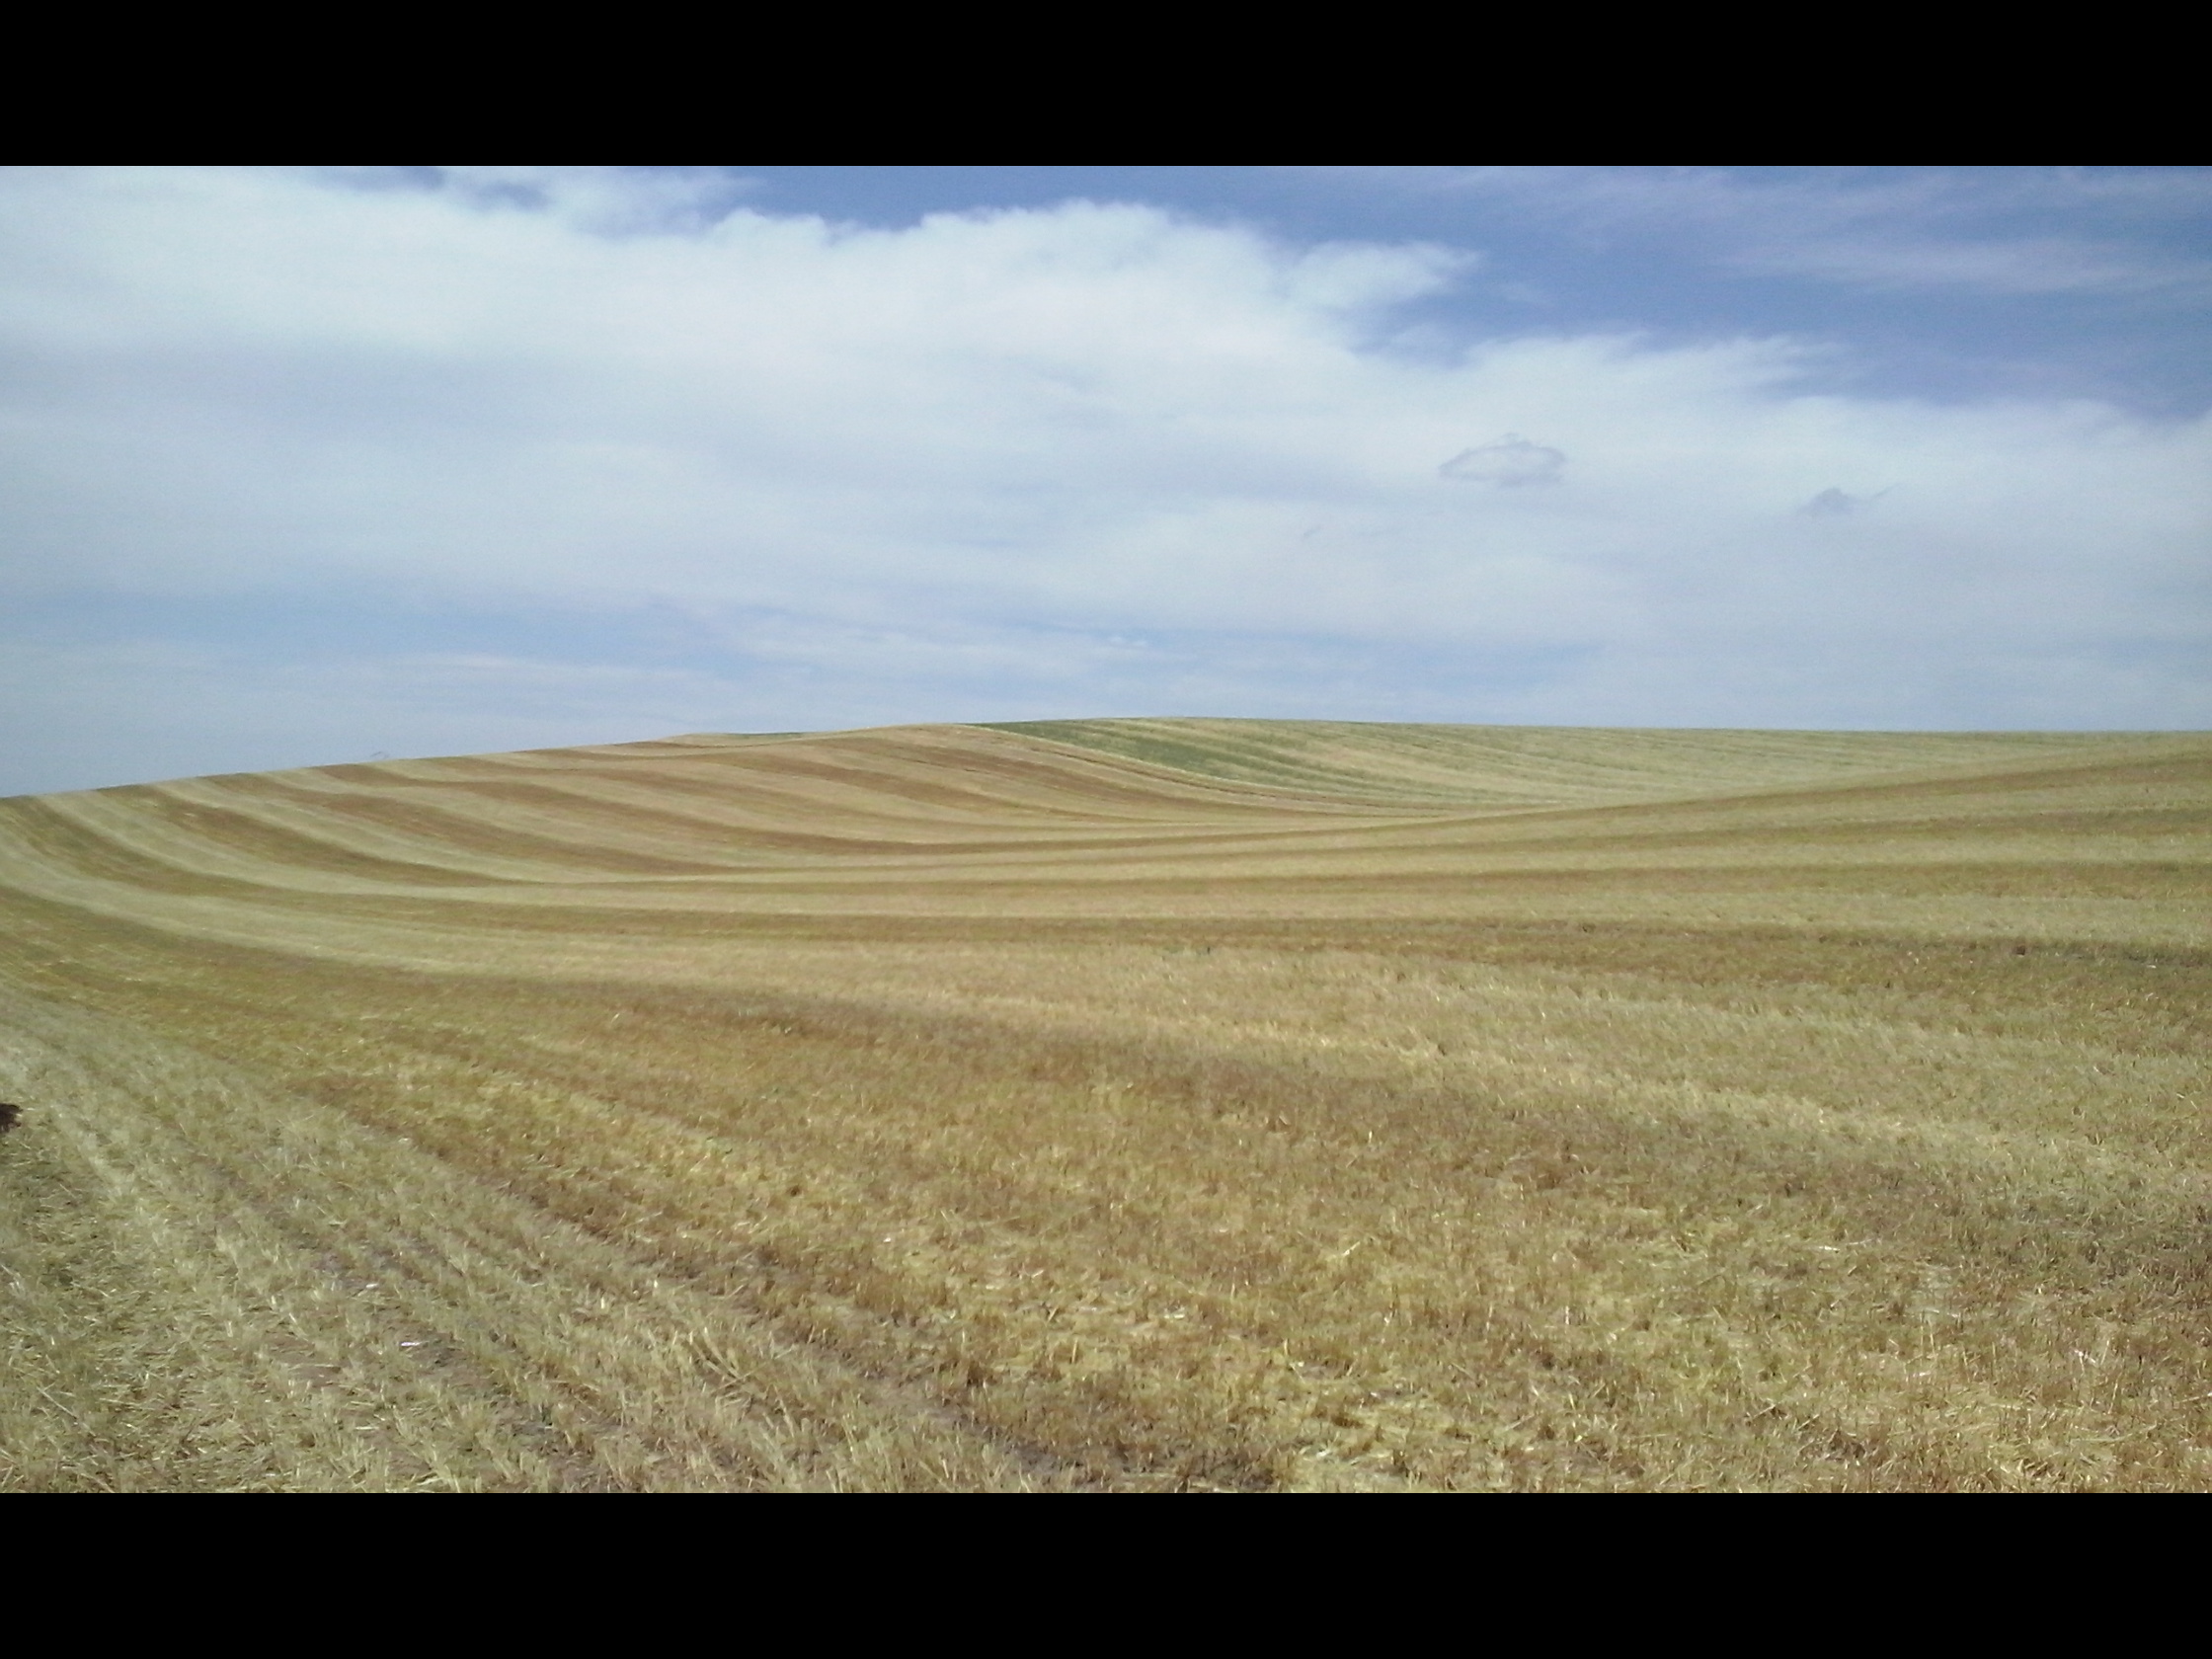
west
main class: Cropland
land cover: Barley
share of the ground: < 10 %
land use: Agriculture (excluding fallow land and kitchen gardens)
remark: Harvested field
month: July
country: ES
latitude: 41.5870
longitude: -5.1055
